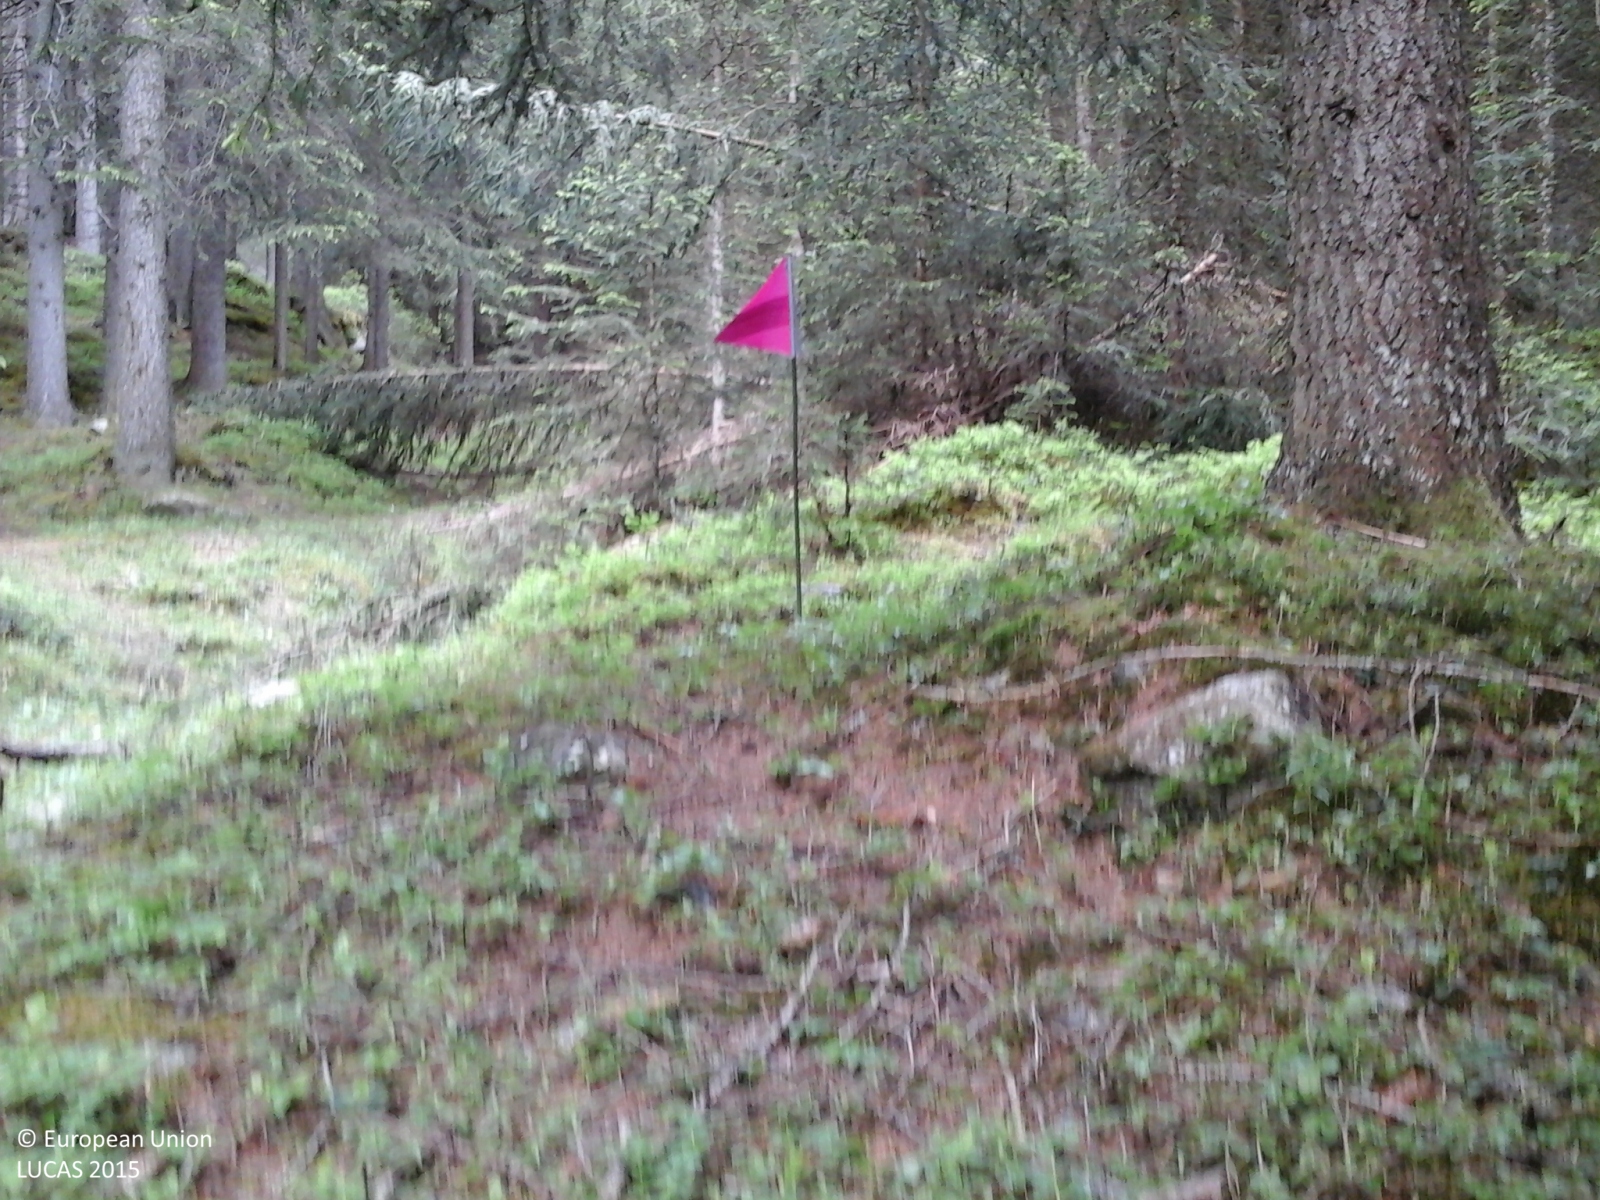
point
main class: Woodland
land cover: Spruce dominated coniferous woodland
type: alpine coniferous forest
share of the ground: > 75 %
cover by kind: coniferous forest trees 100 %
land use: Forestry
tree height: > 5 m
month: June
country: IT
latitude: 46.9699
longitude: 11.5888
